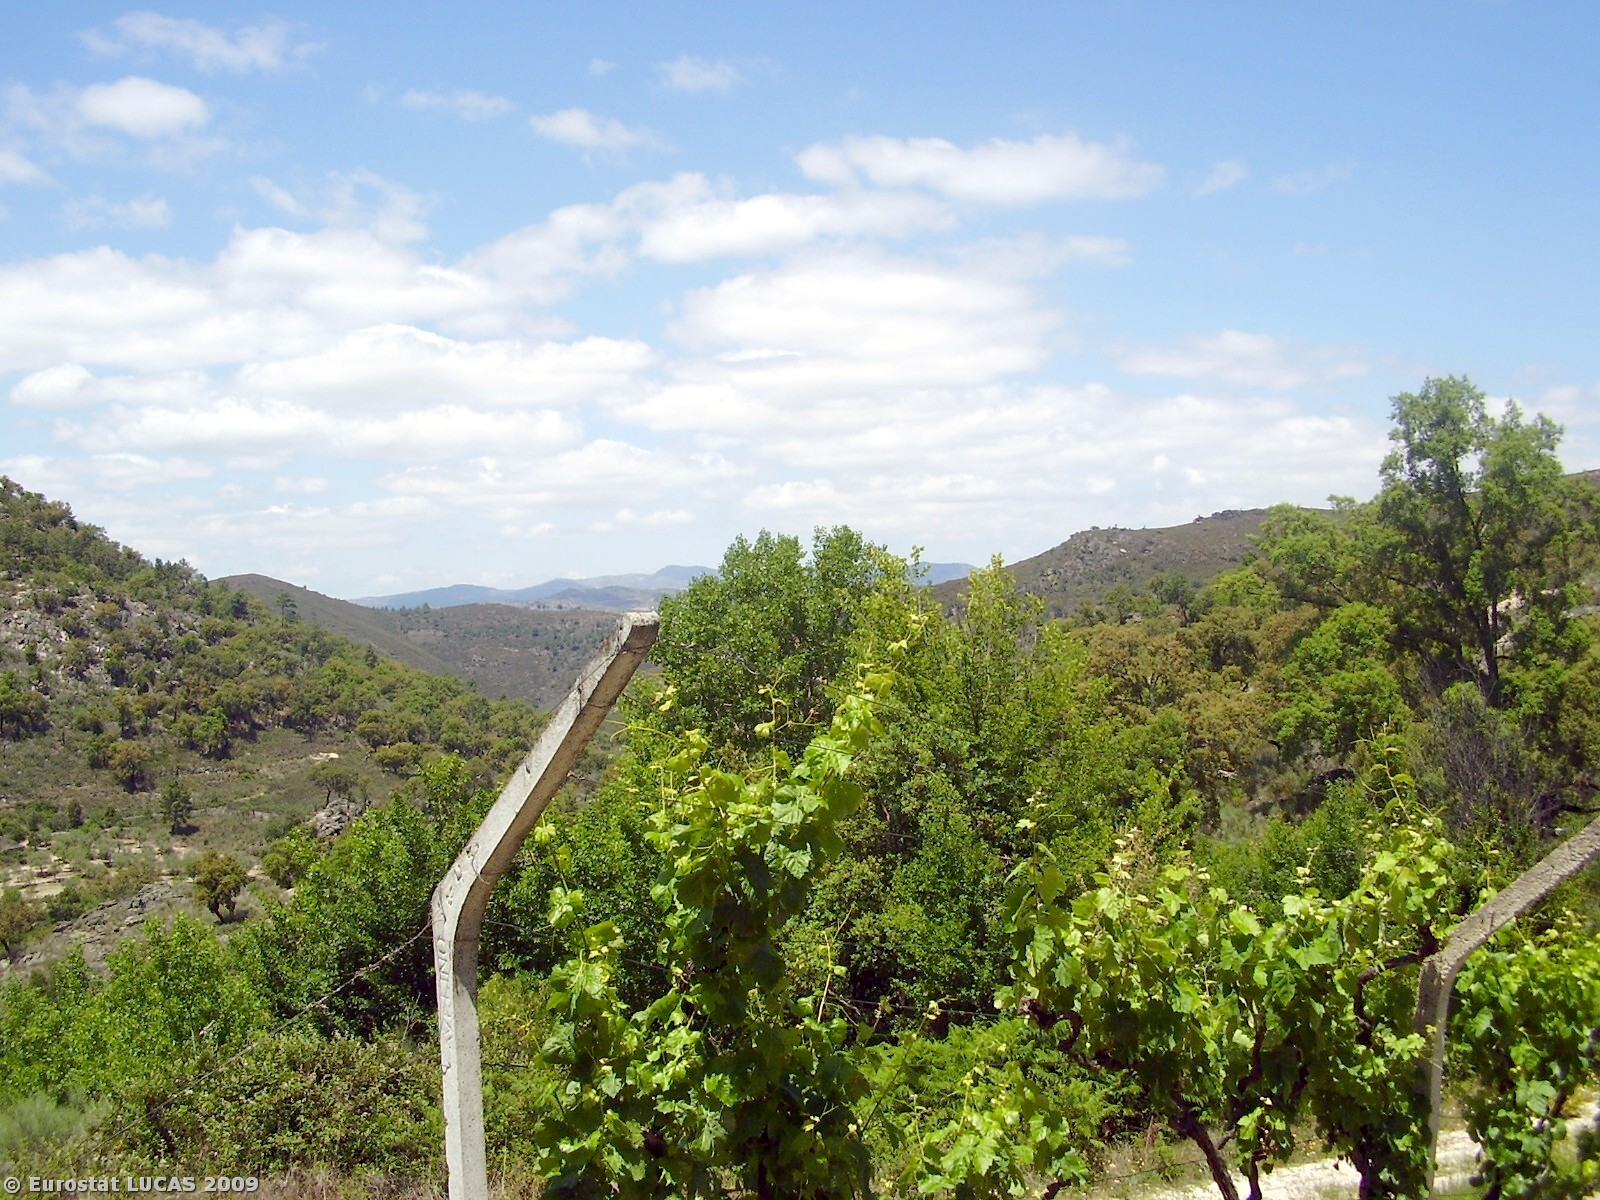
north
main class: Cropland
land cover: Vineyards
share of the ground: 10 - 25 %
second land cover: Bare land
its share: > 75 %
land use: Agriculture (excluding fallow land and kitchen gardens)
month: May
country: PT
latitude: 41.3203
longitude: -7.2861
